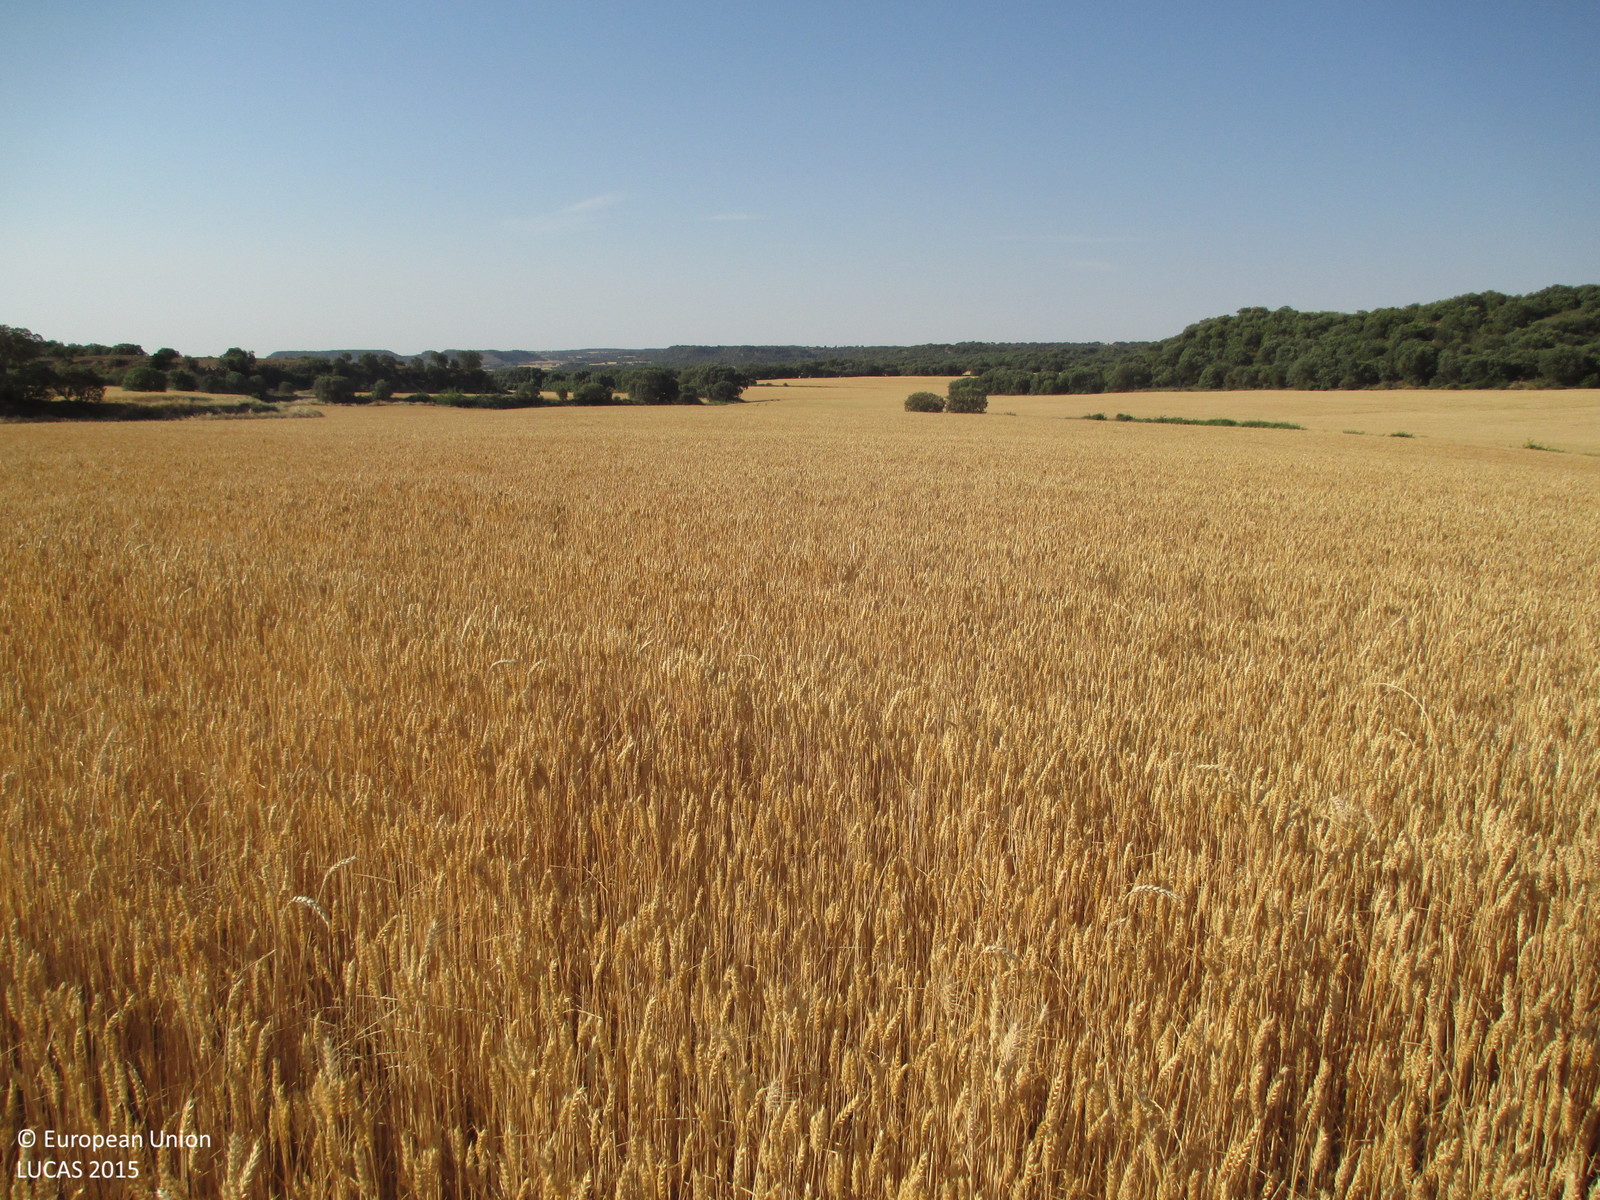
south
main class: Cropland
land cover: Common wheat
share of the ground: > 75 %
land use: Agriculture (excluding fallow land and kitchen gardens)
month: June
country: ES
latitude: 42.1512
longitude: -0.2473
